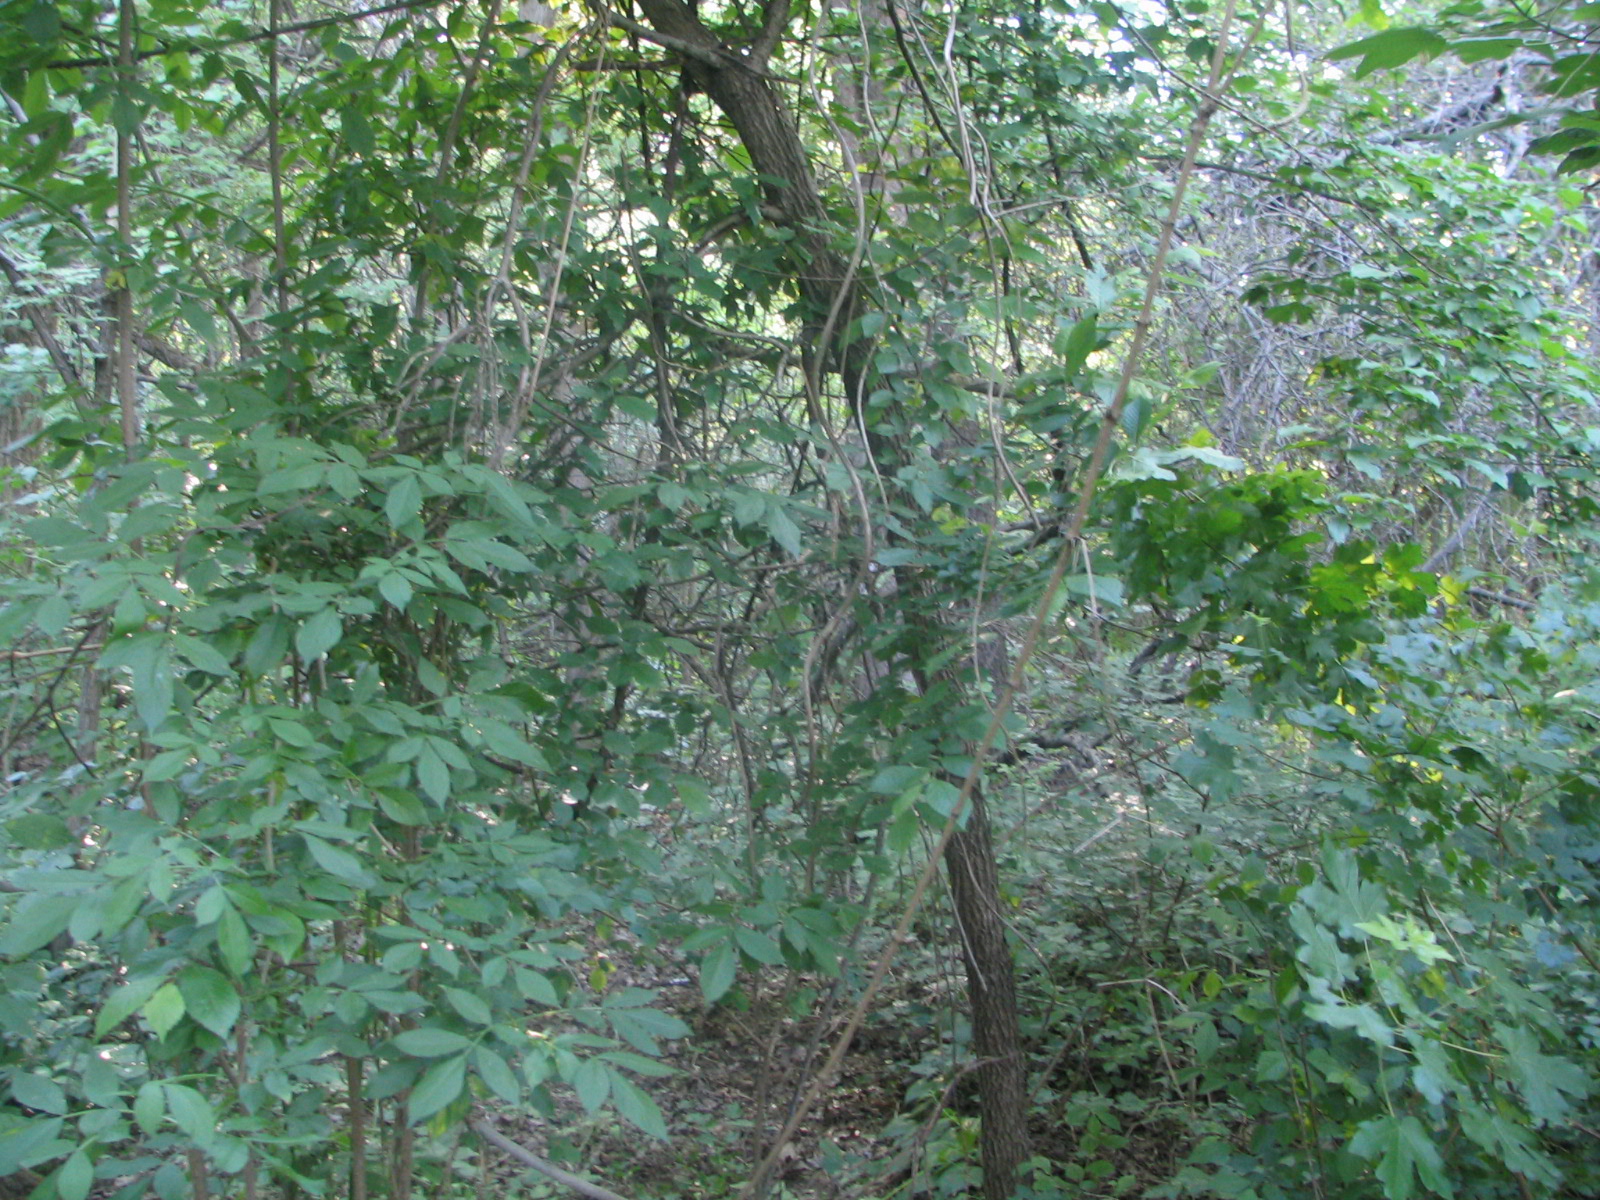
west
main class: Woodland
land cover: Broadleaved woodland
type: mesophytic deciduous forest
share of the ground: > 75 %
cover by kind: broadleaved forest trees 90 %, shrubs 5 %, herbaceous plants 5 %
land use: Forestry
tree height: > 5 m
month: May
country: BG
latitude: 43.6803
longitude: 24.0602
